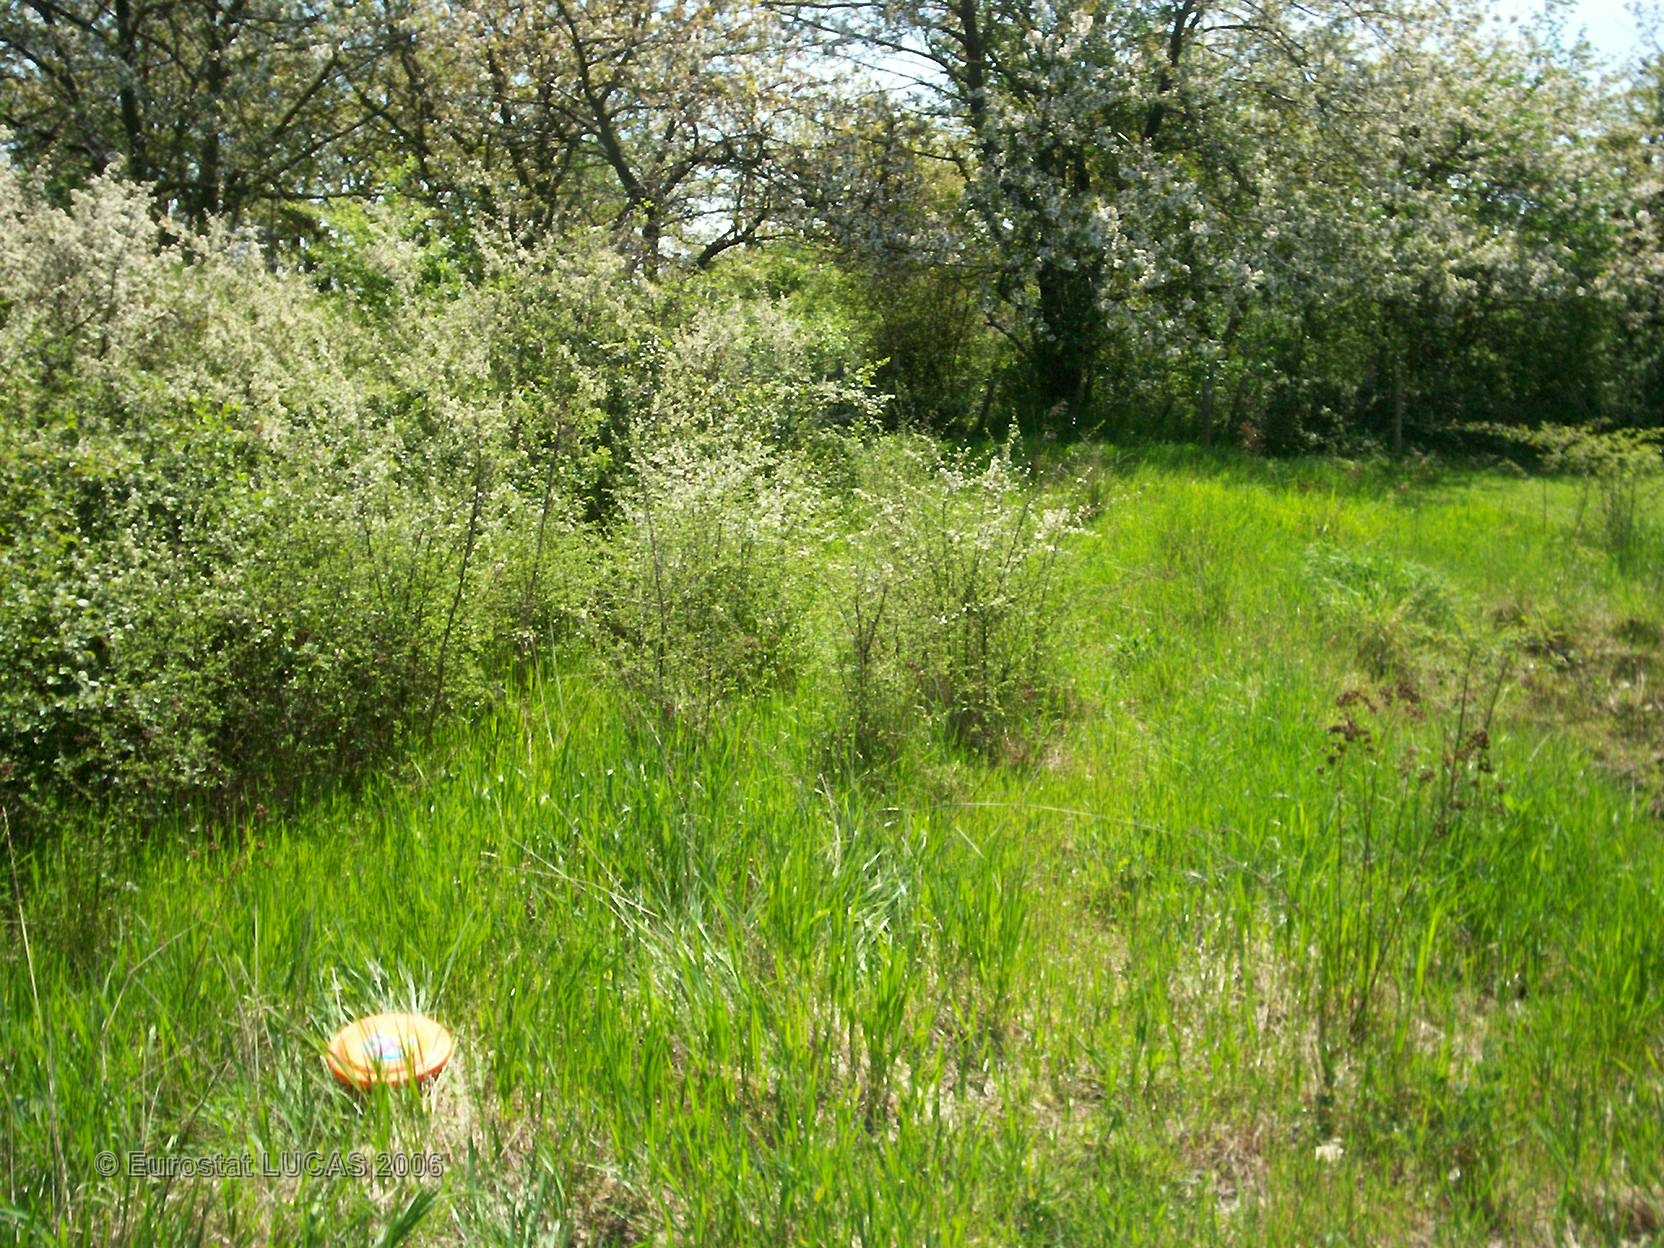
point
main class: Grassland
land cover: Grassland with sparse tree/shrub cover
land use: Agriculture (excluding fallow land and kitchen gardens)
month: April
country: FR
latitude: 45.5948
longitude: 4.8378
